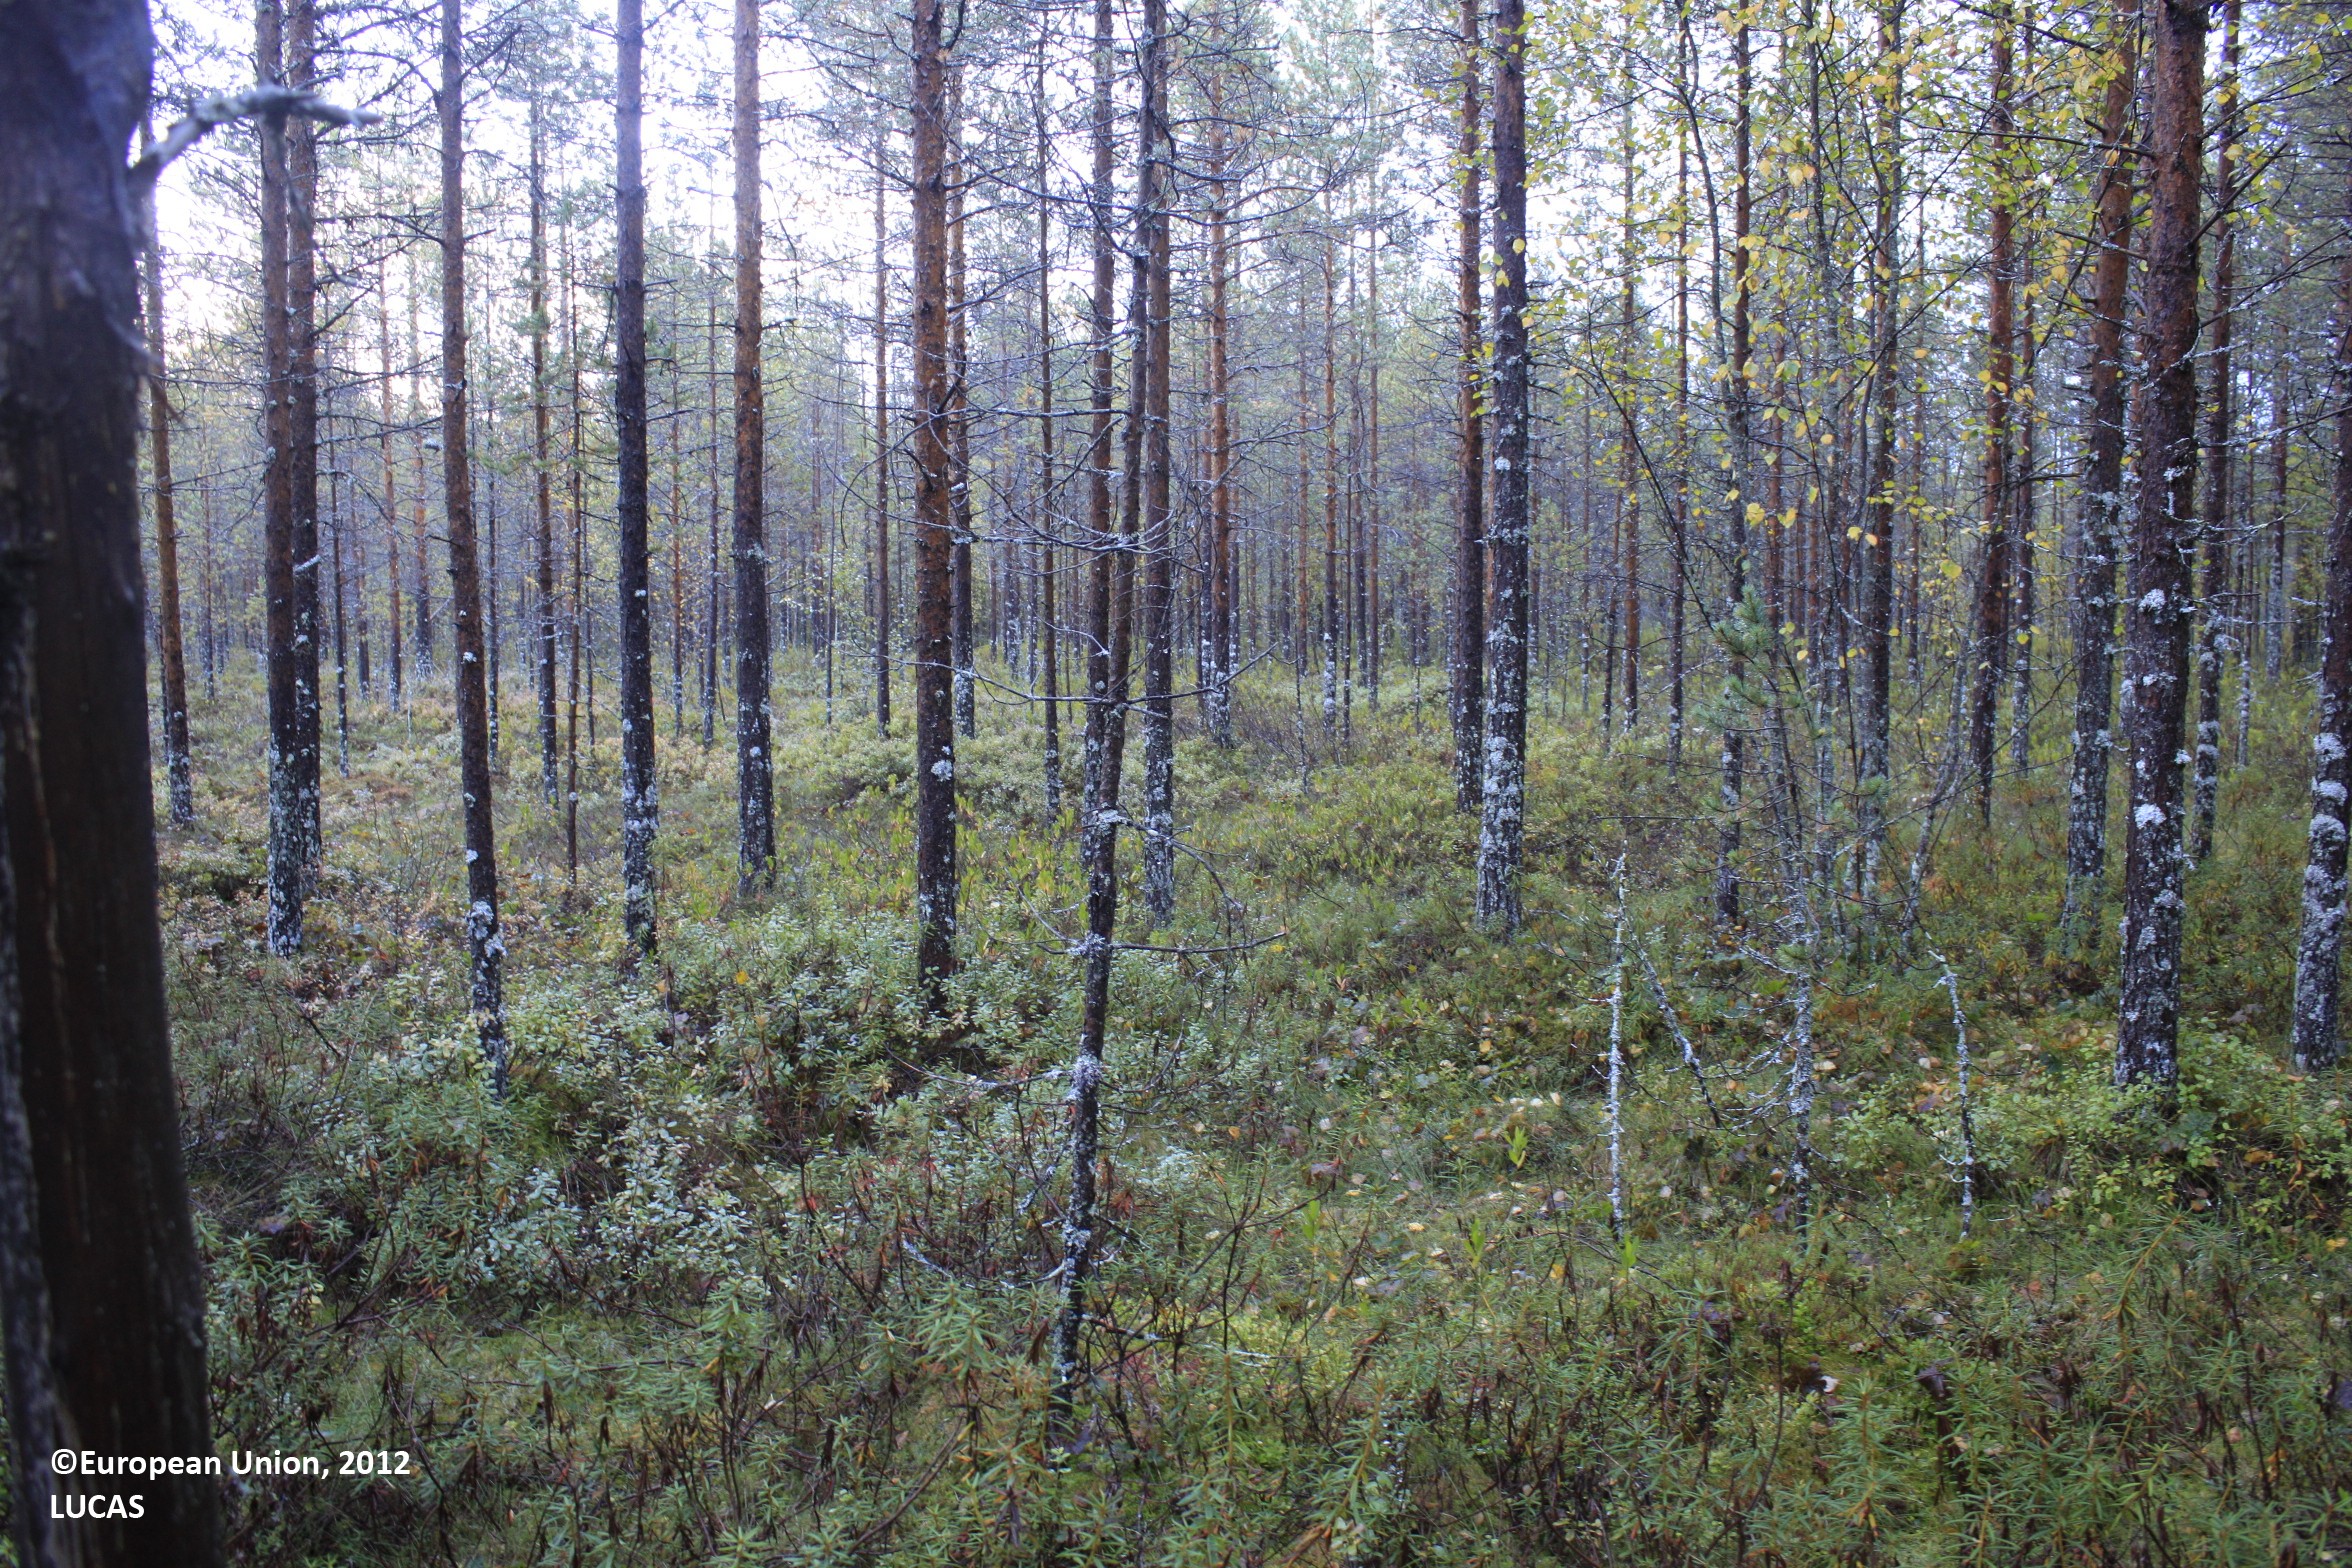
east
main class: Woodland
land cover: Pine dominated mixed woodland
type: boreal forest
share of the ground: 50 - 75 %
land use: Forestry
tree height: > 5 m
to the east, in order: Pine dominated mixed woodland; Ditches and canals; Pine dominated mixed woodland; Ditches and canals; Pine dominated mixed woodland; Ditches and canals; Pine dominated mixed woodland; Ditches and canals; Broadleaved woodland; Ditches and canals; Broadleaved woodland
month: September
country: FI
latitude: 65.2752
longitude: 26.9806
